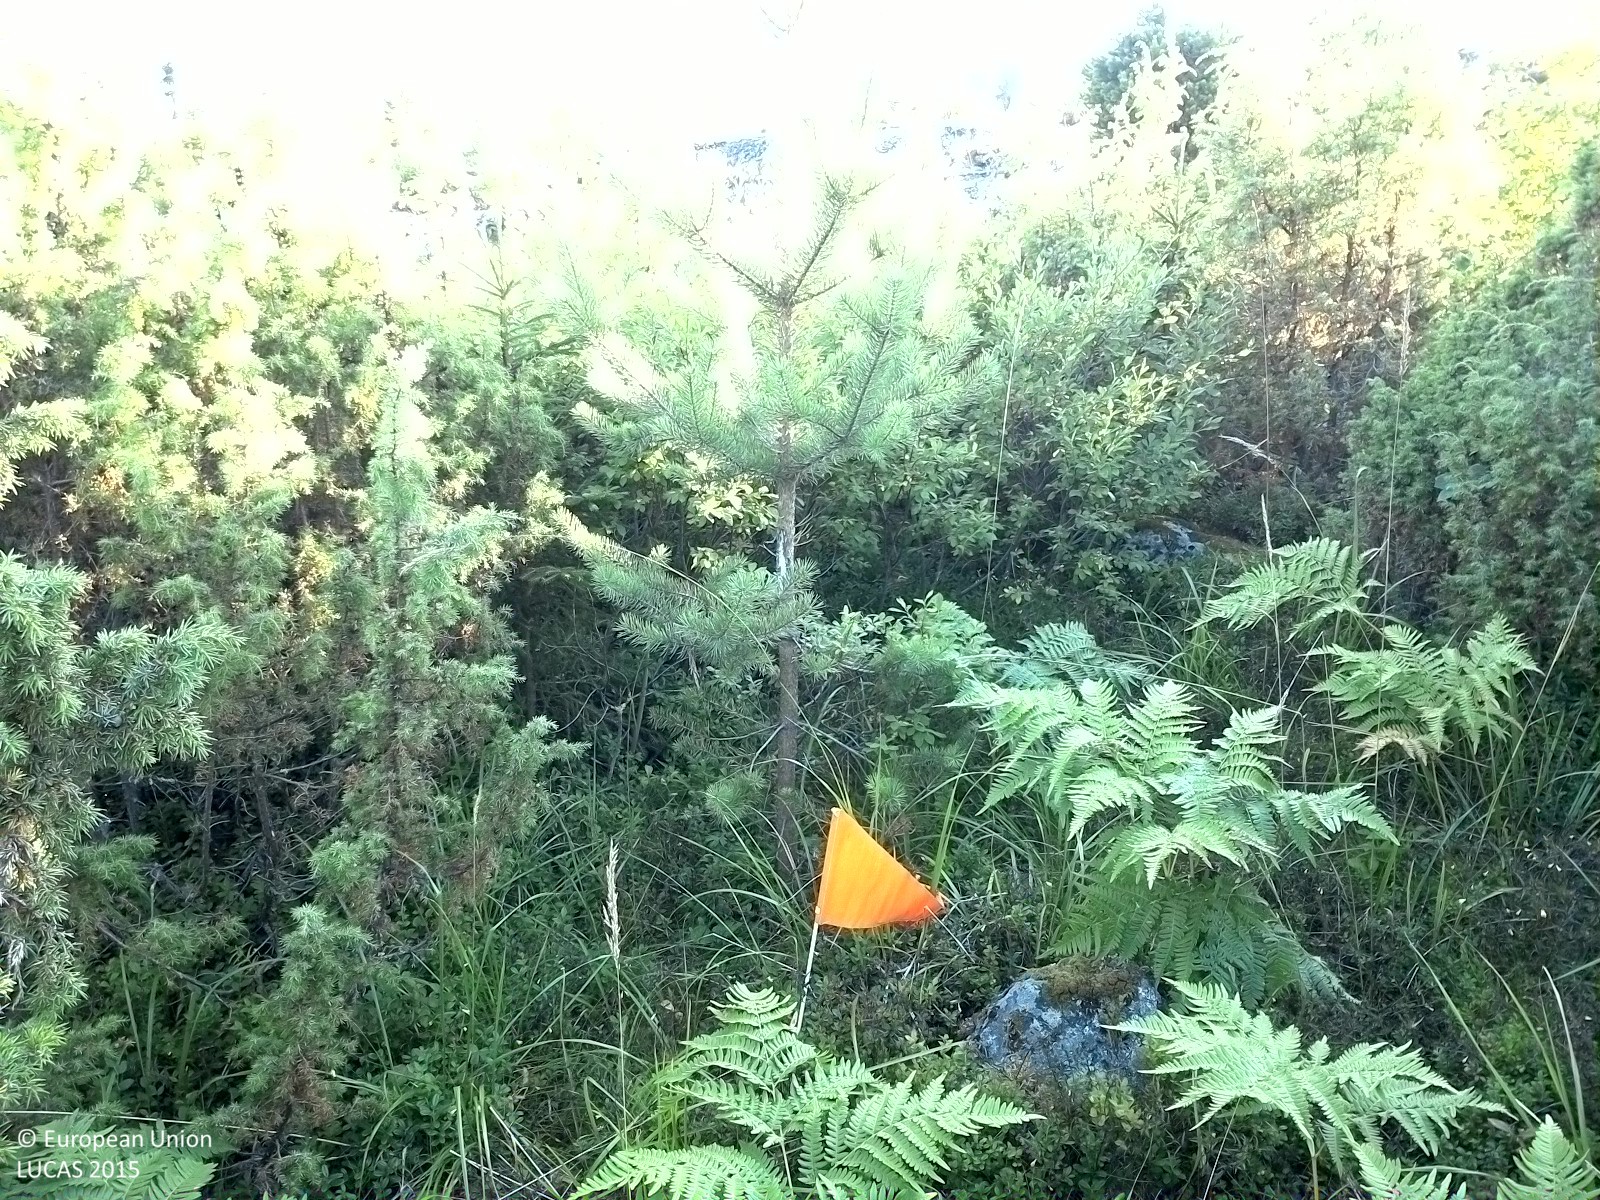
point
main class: Woodland
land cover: Pine dominated mixed woodland
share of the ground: 50 - 75 %
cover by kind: coniferous forest trees 35 %, shrubs 35 %, broadleaved forest trees 20 %, herbaceous plants 10 %
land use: Electricity, gas and thermal power distribution
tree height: < 5 m
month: August
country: SE
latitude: 62.3790
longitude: 16.9598
